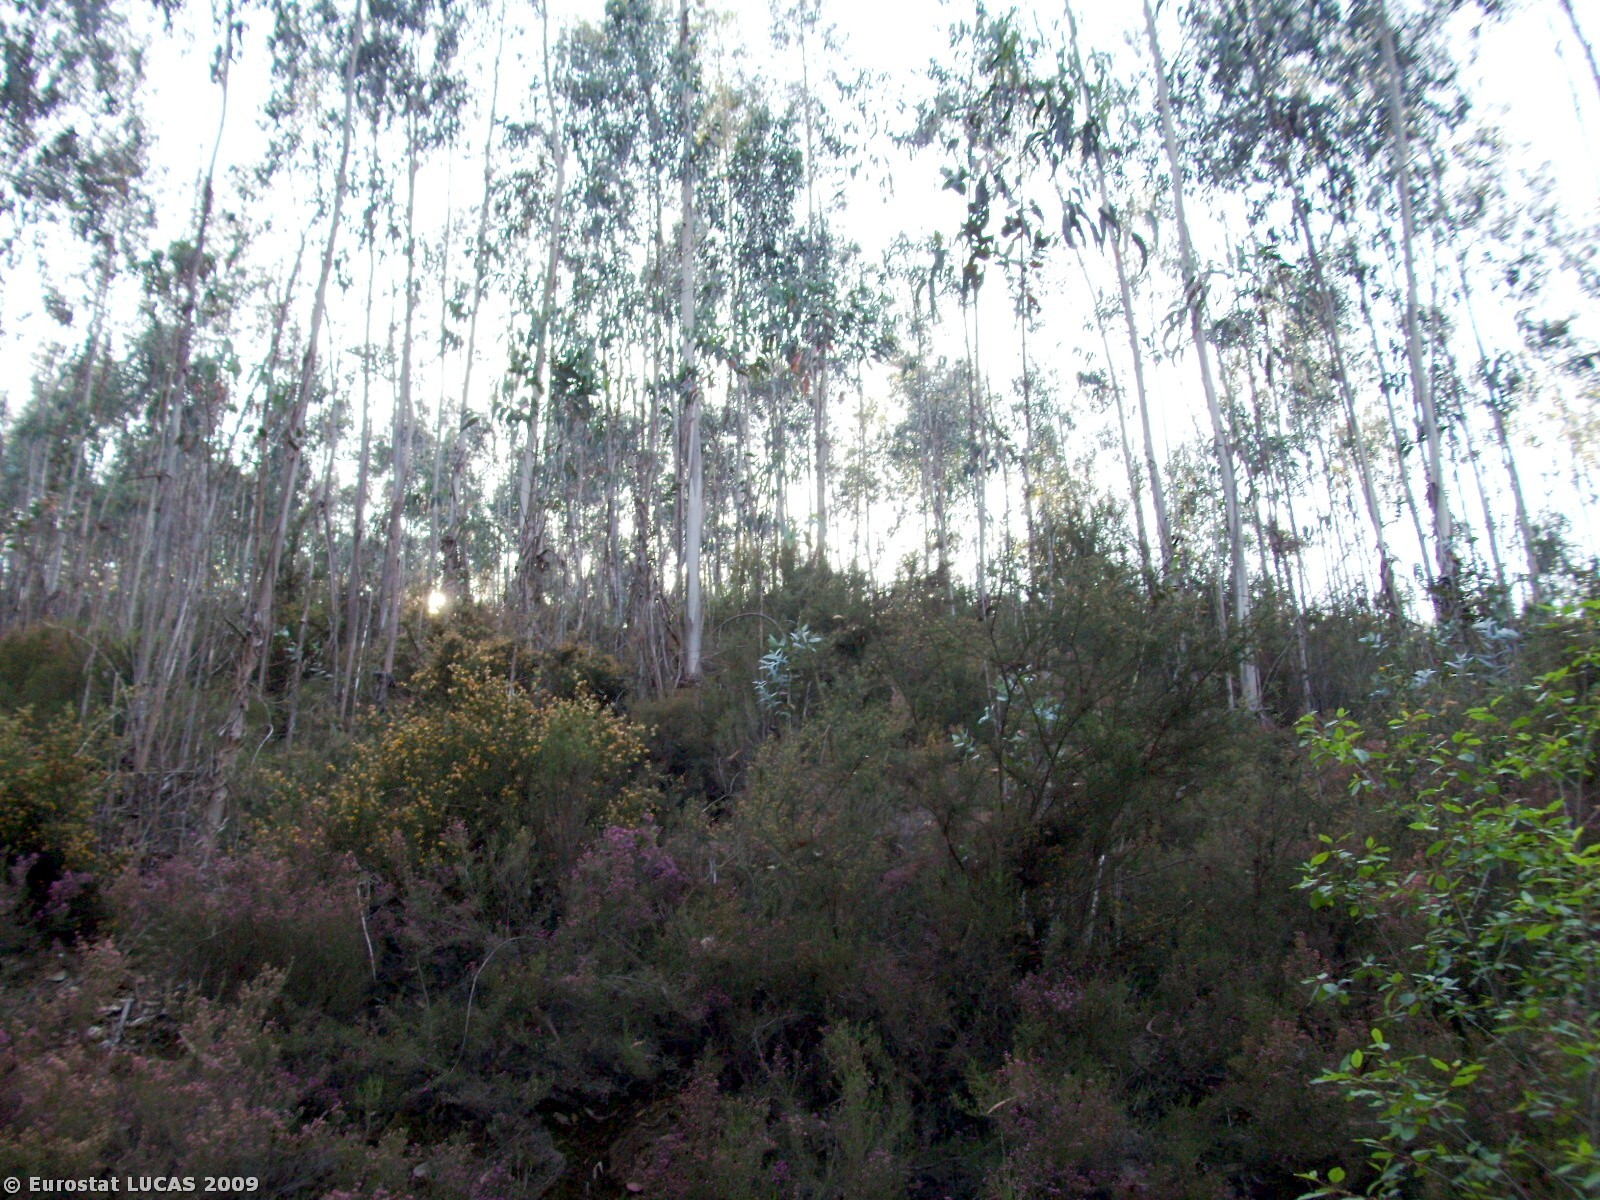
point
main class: Woodland
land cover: Broadleaved woodland
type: plantations and self-sown exotic forest
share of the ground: > 75 %
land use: Forestry
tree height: > 5 m
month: May
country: PT
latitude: 40.5834
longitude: -8.3895
